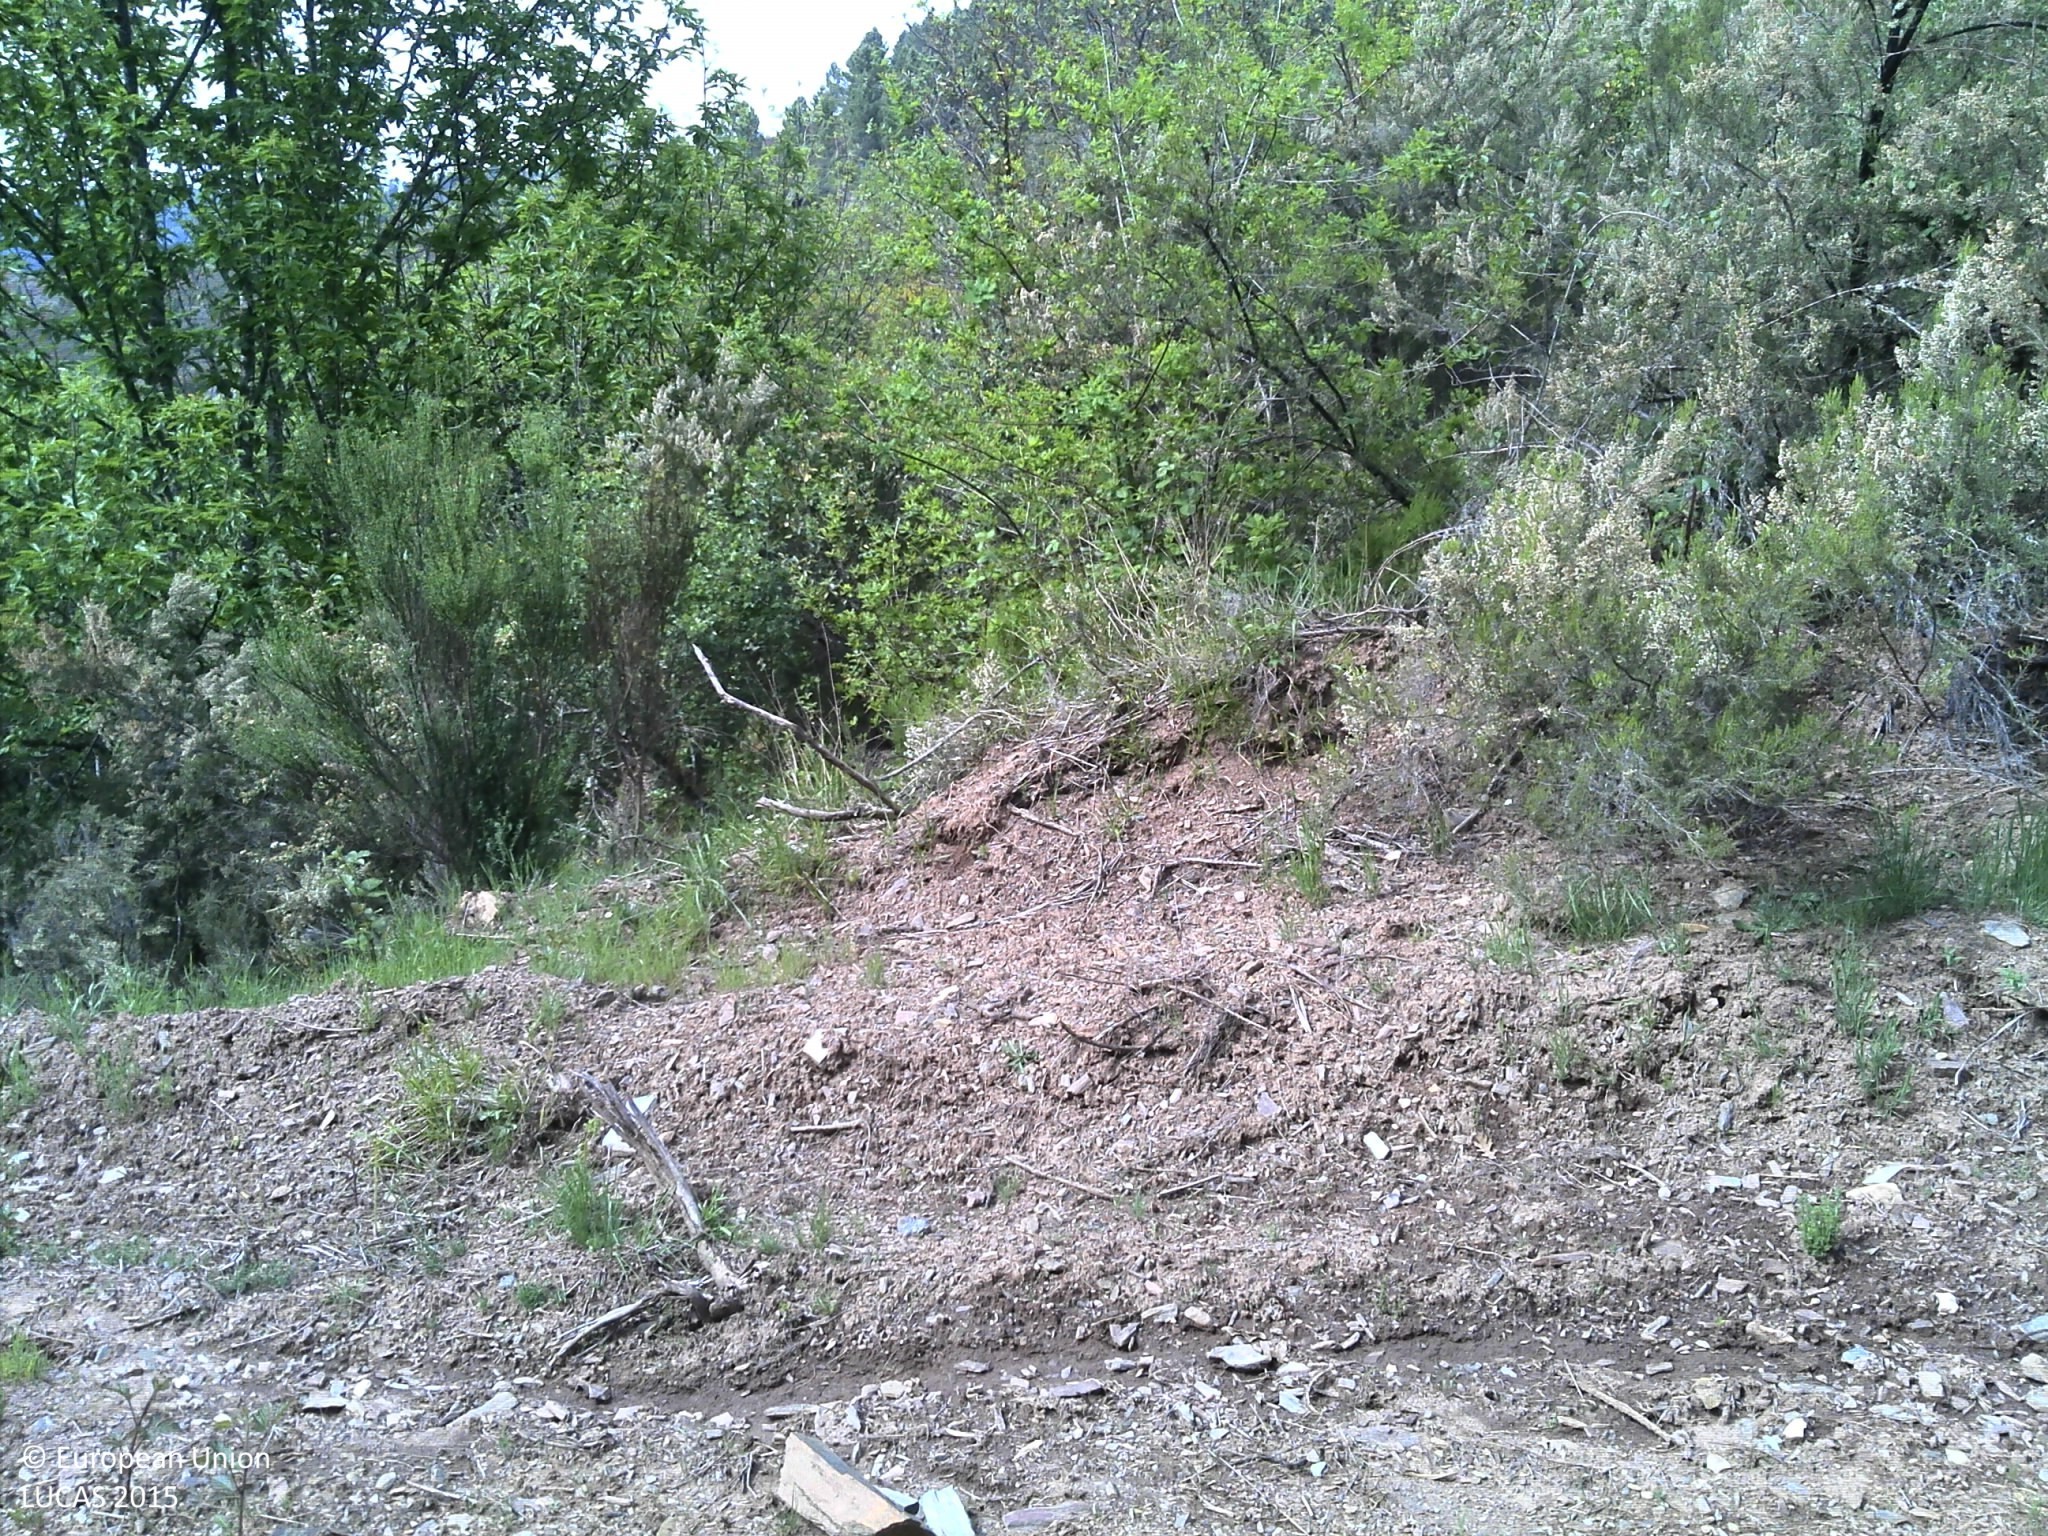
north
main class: Shrubland
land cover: Shrubland with sparse tree cover
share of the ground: > 75 %
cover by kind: shrubs 95 %, broadleaved forest trees 5 %
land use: Forestry
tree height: > 5 m
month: May
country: PT
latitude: 41.9526
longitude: -7.1470
